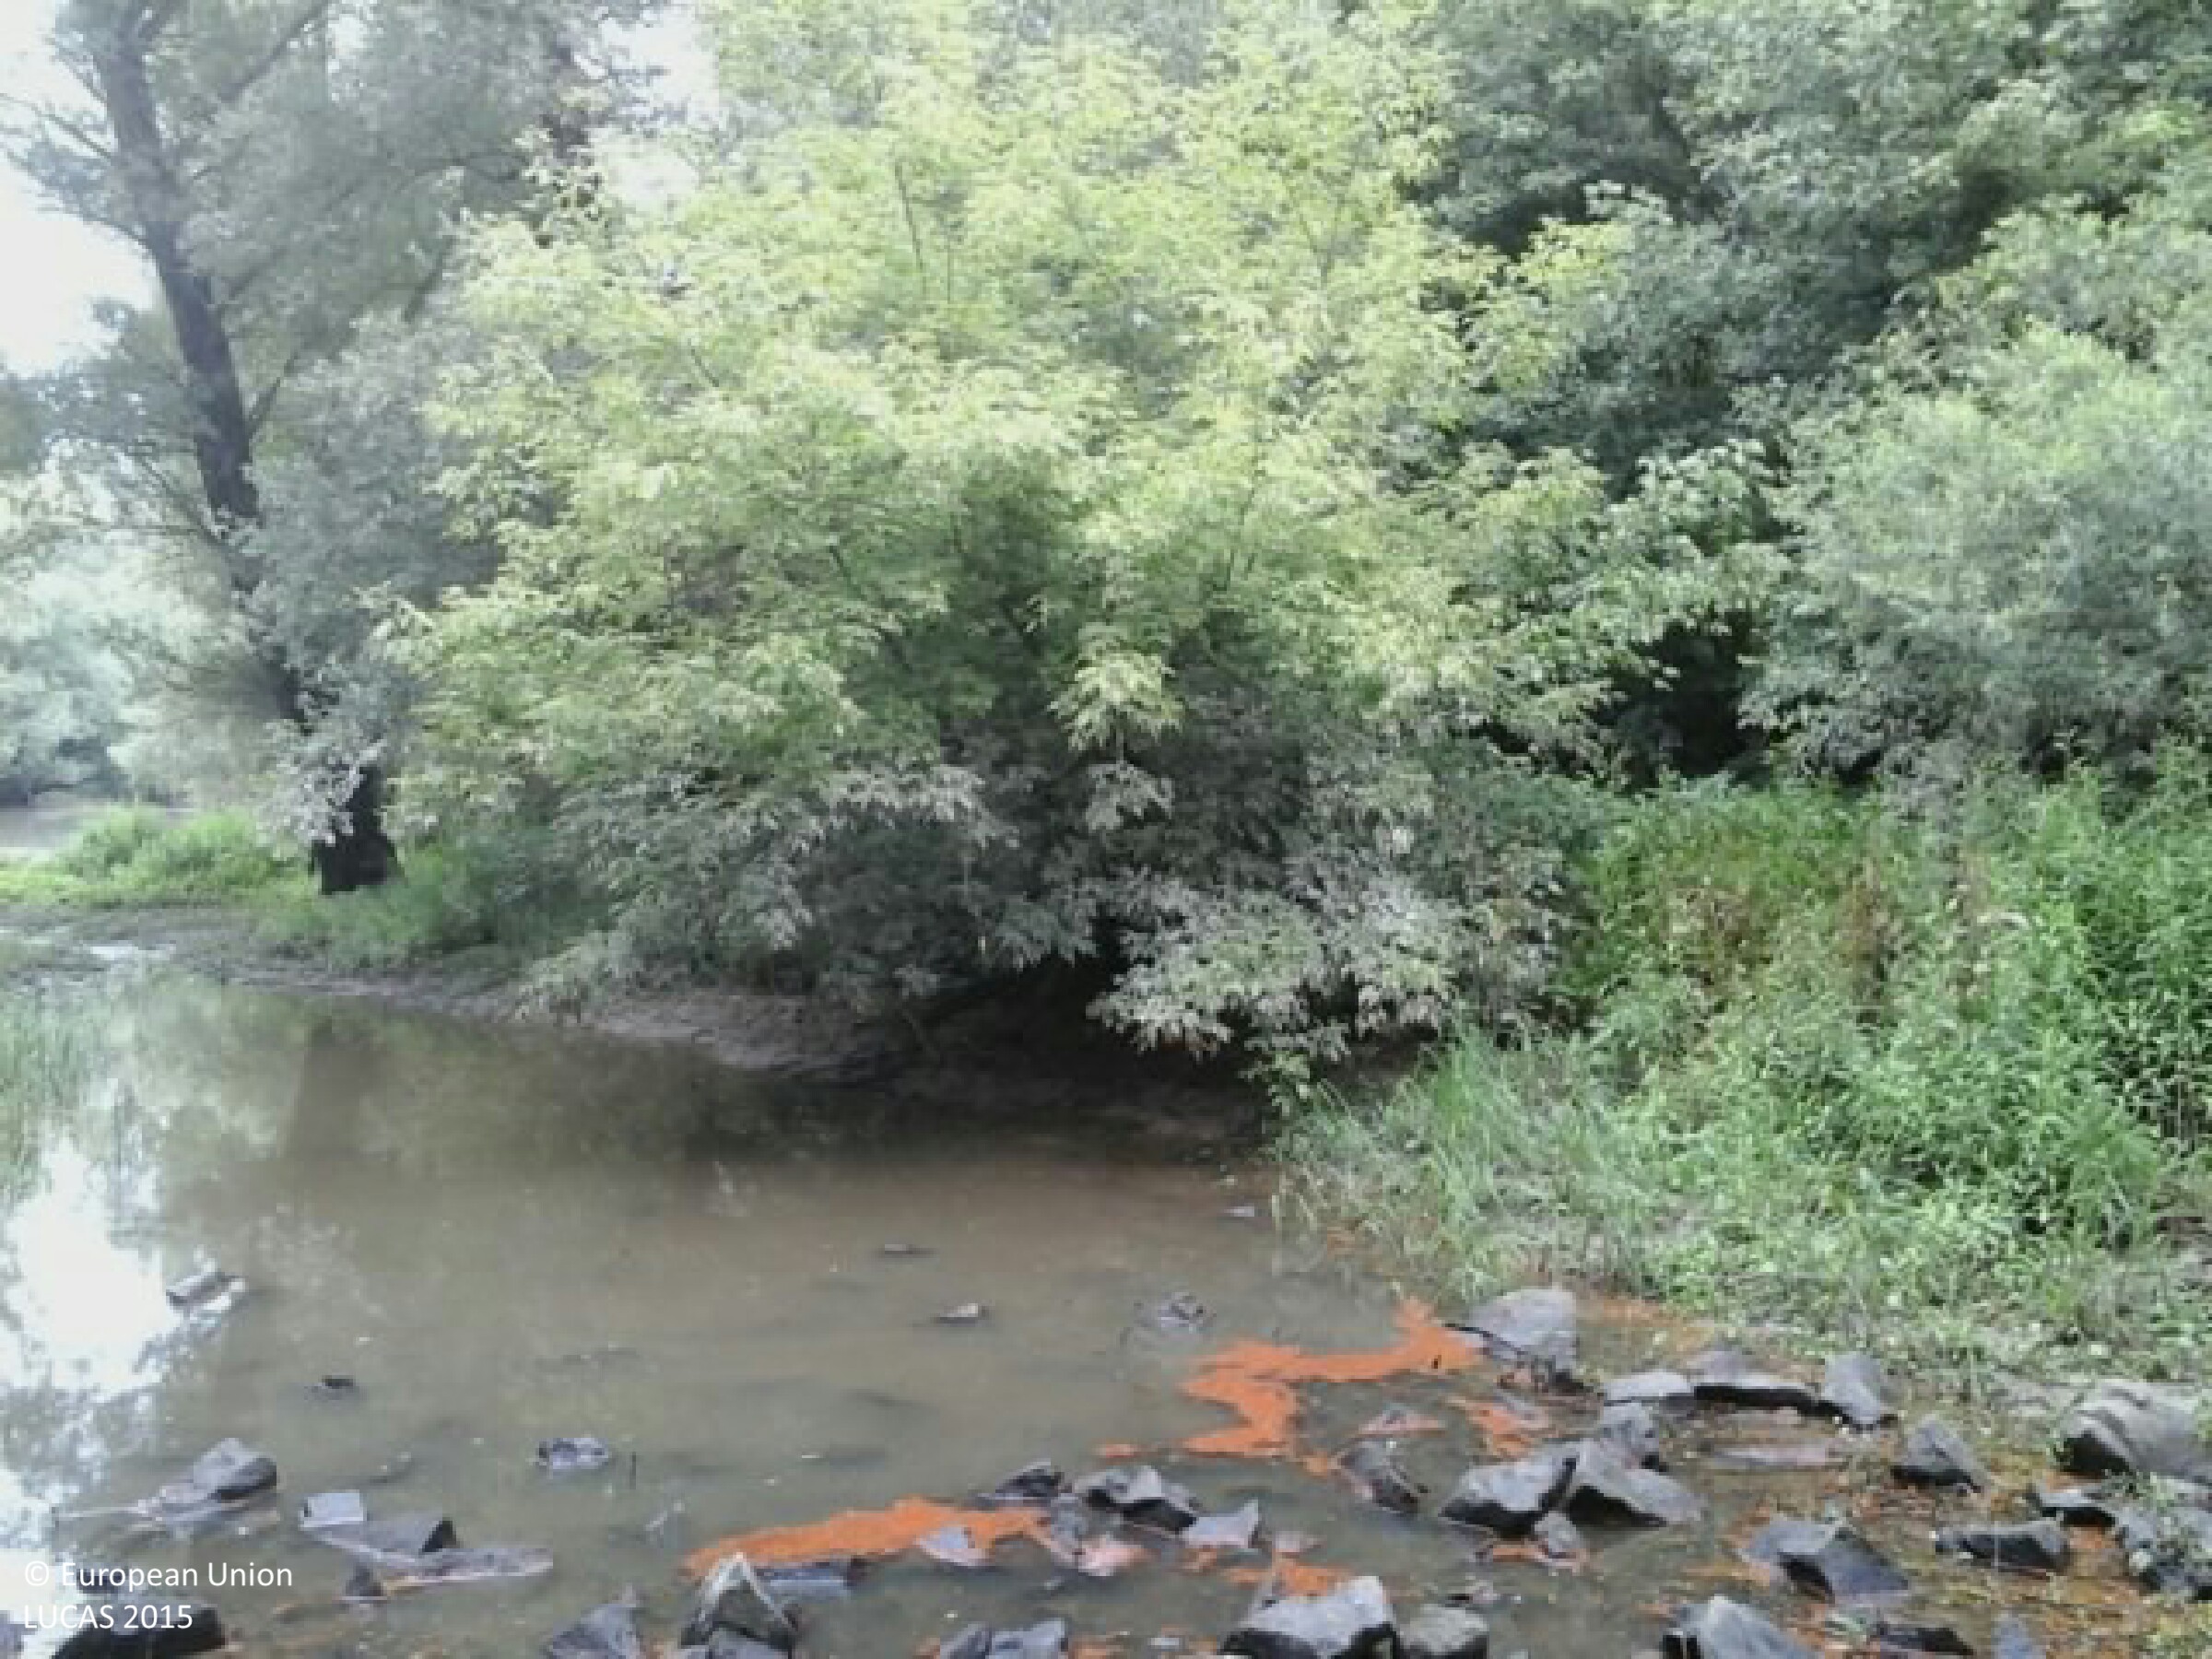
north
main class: Woodland
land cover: Broadleaved woodland
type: mesophytic deciduous forest
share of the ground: 50 - 75 %
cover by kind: broadleaved forest trees 60 %, shrubs 15 %, herbaceous plants 15 %, unconsolidated bare surface 10 %
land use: Forestry
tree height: > 5 m
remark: Temporary dry
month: July
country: HU
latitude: 46.4860
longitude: 18.9103
